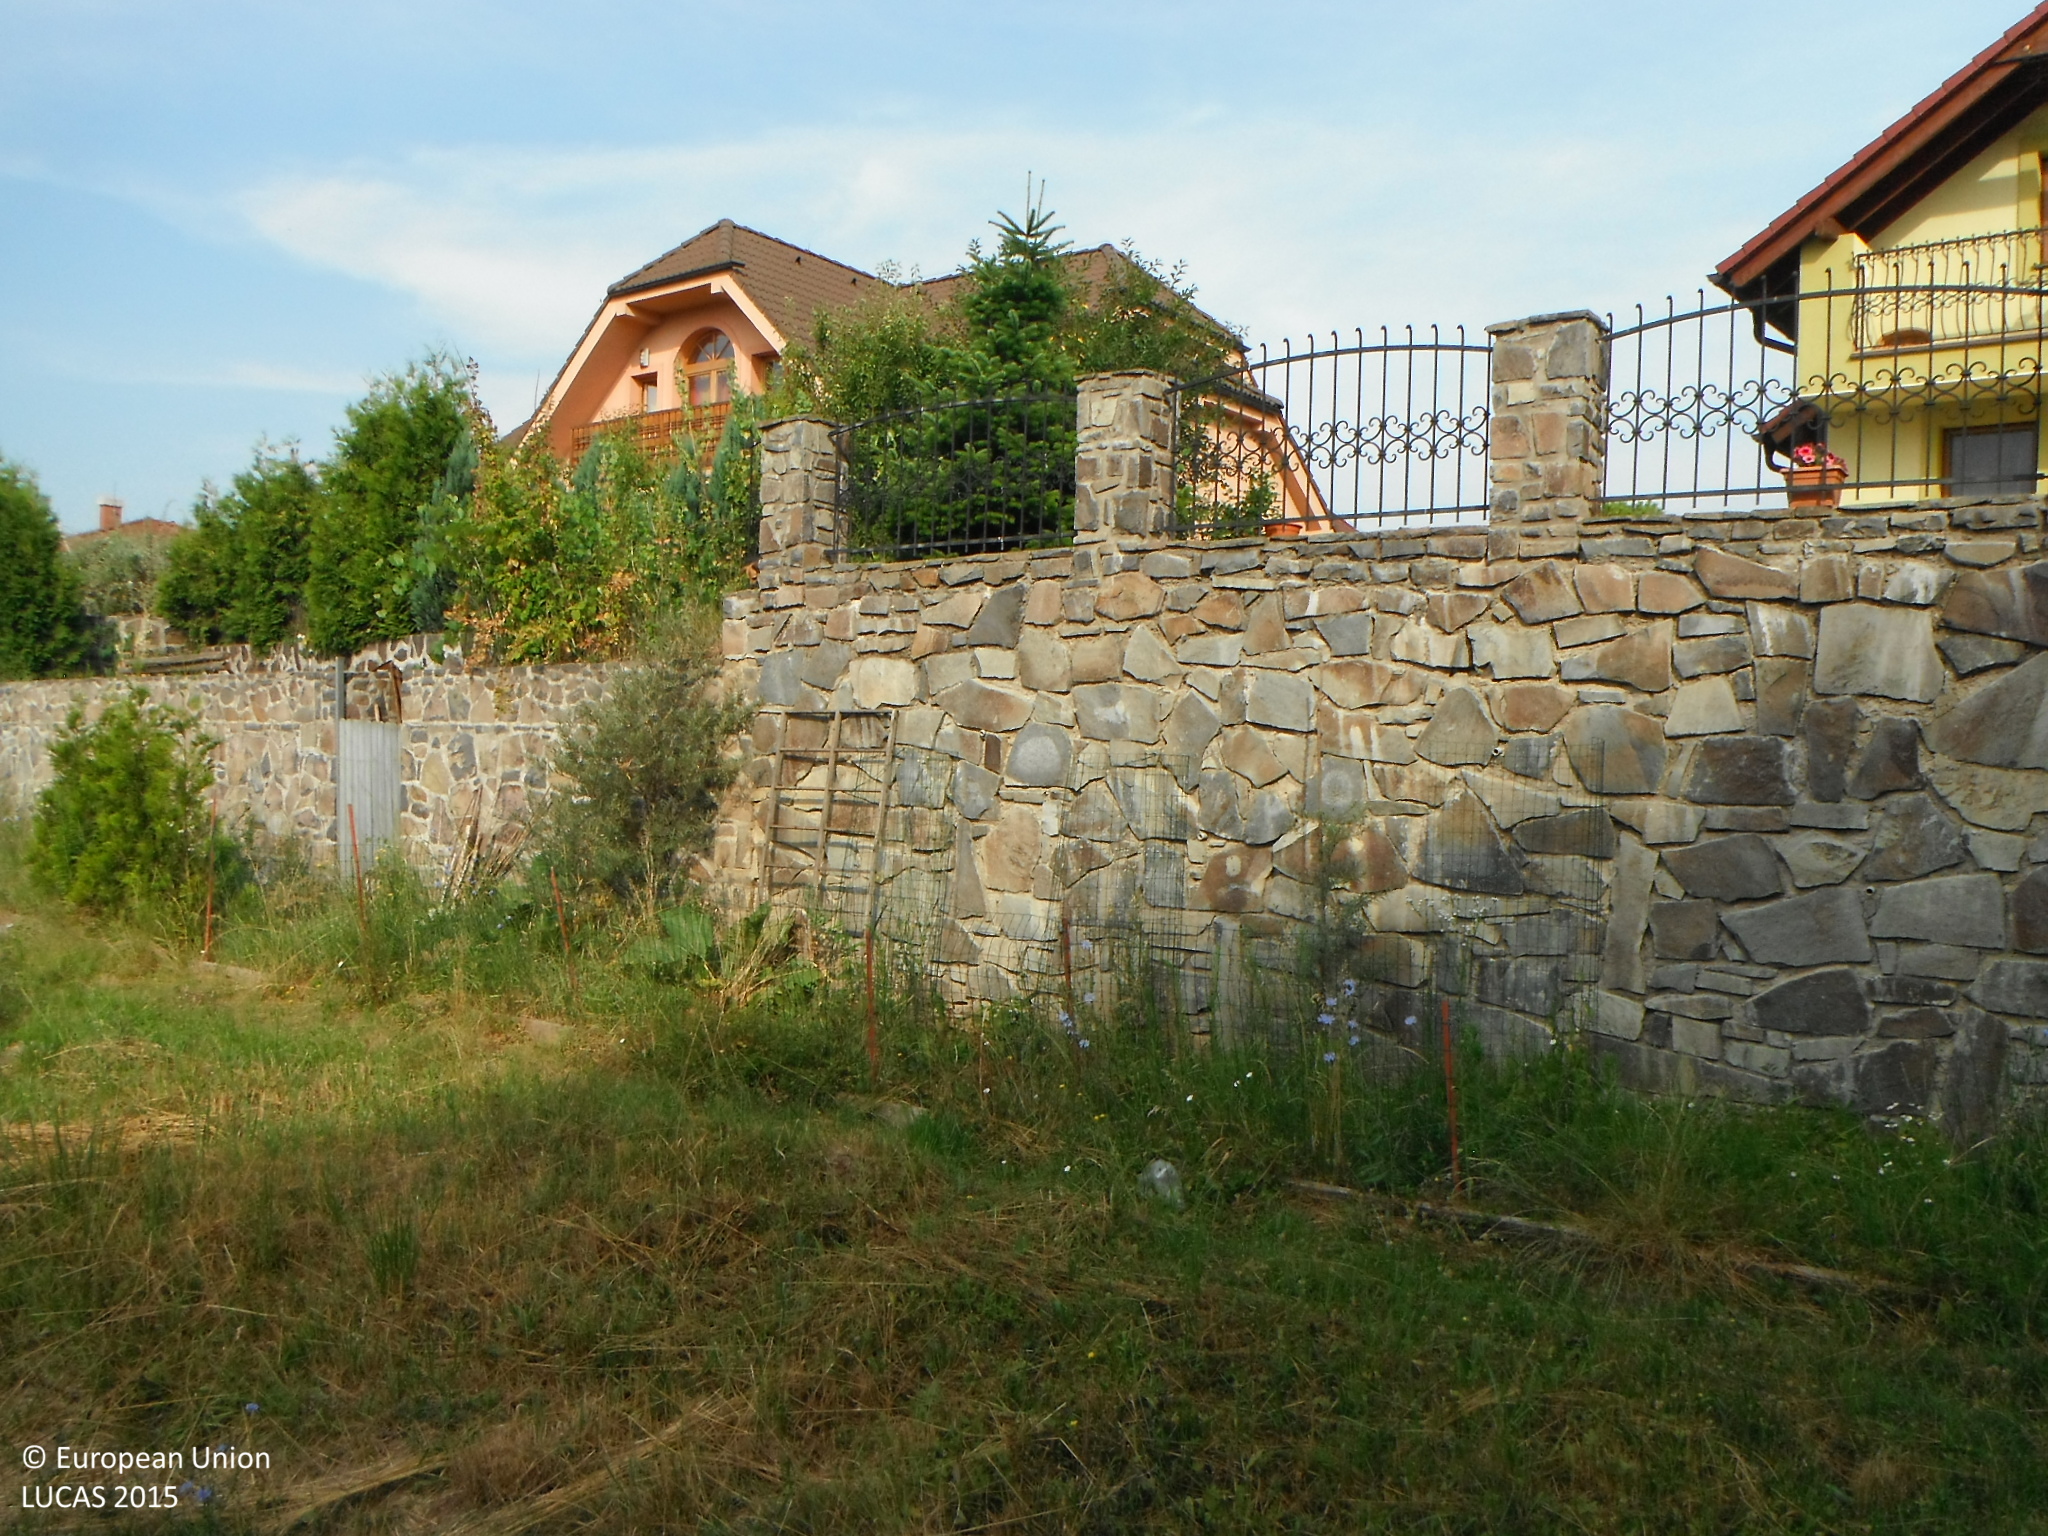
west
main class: Grassland
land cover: Grassland without tree/shrub cover
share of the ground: > 75 %
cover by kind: herbaceous plants 100 %
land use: Agriculture (excluding fallow land and kitchen gardens)
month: July
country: SK
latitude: 48.5851
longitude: 19.1455
